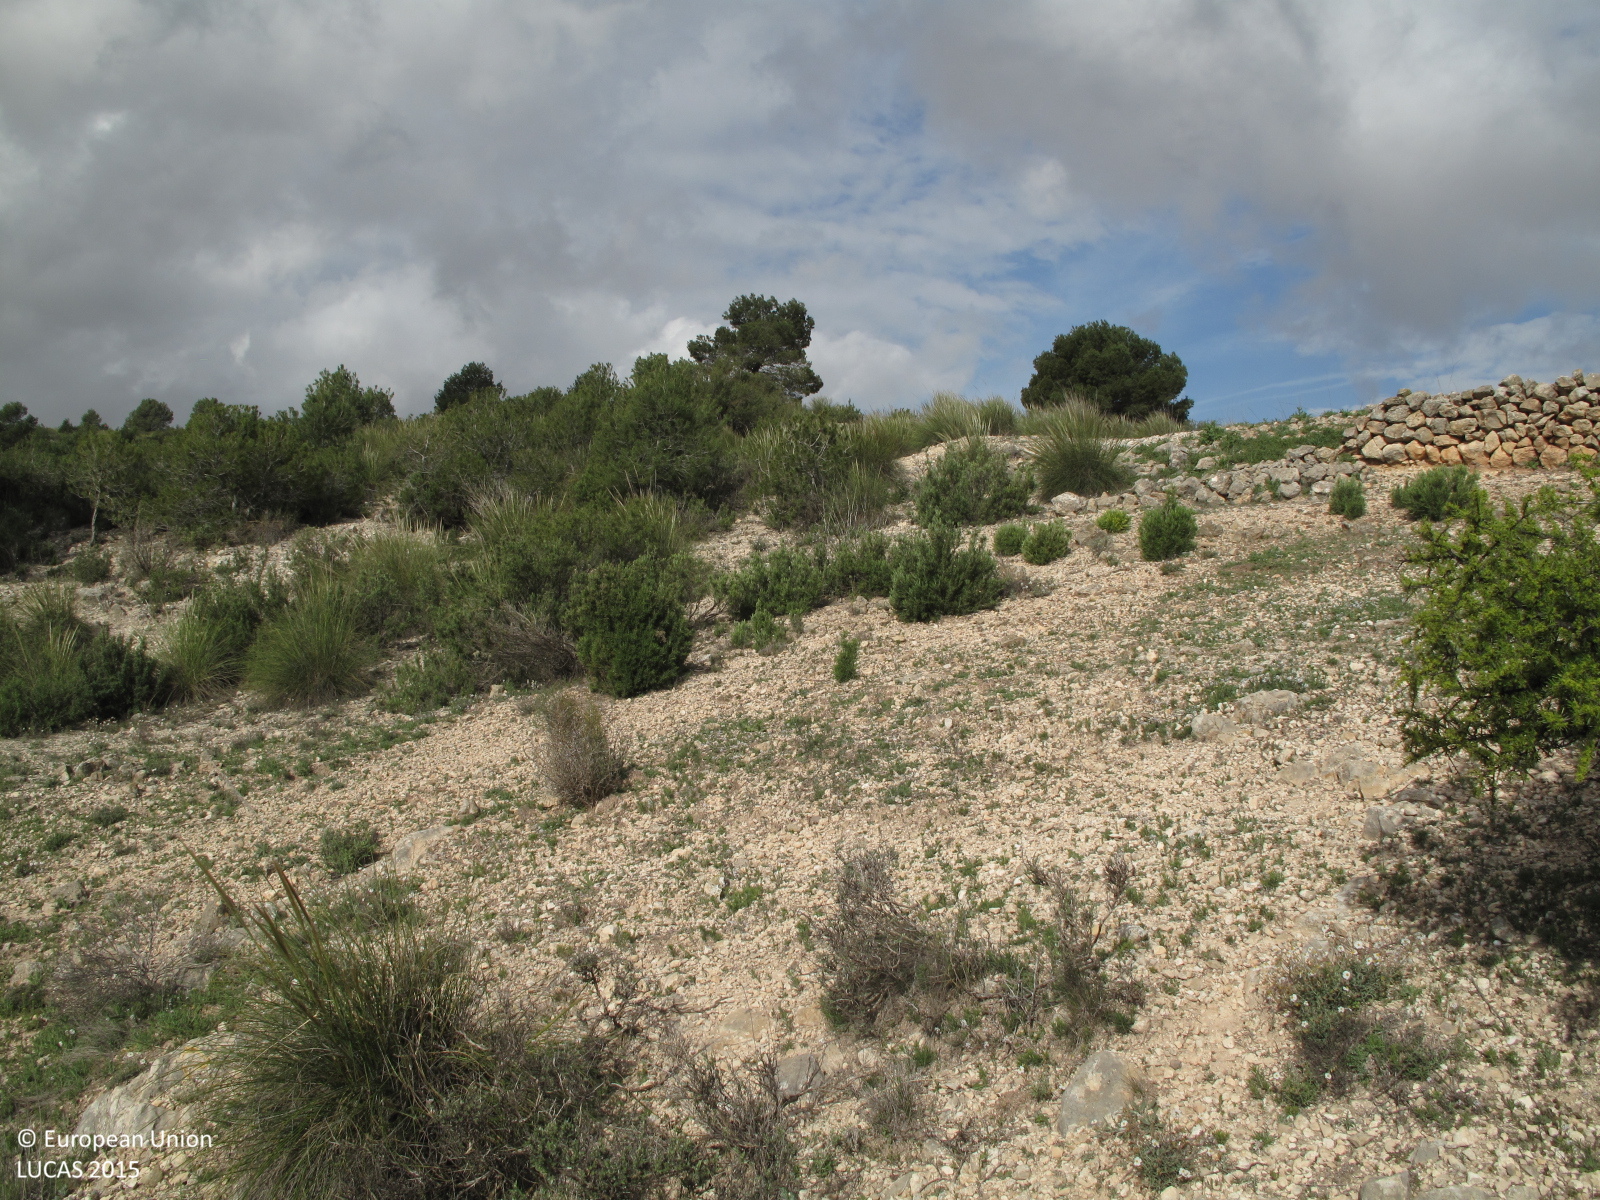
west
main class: Shrubland
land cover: Shrubland with sparse tree cover
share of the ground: 25 - 50 %
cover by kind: unconsolidated bare surface 55 %, shrubs 20 %, herbaceous plants 20 %, coniferous forest trees 5 %
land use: Semi-natural and natural areas not in use
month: April
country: ES
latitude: 38.6802
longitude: -0.9922
